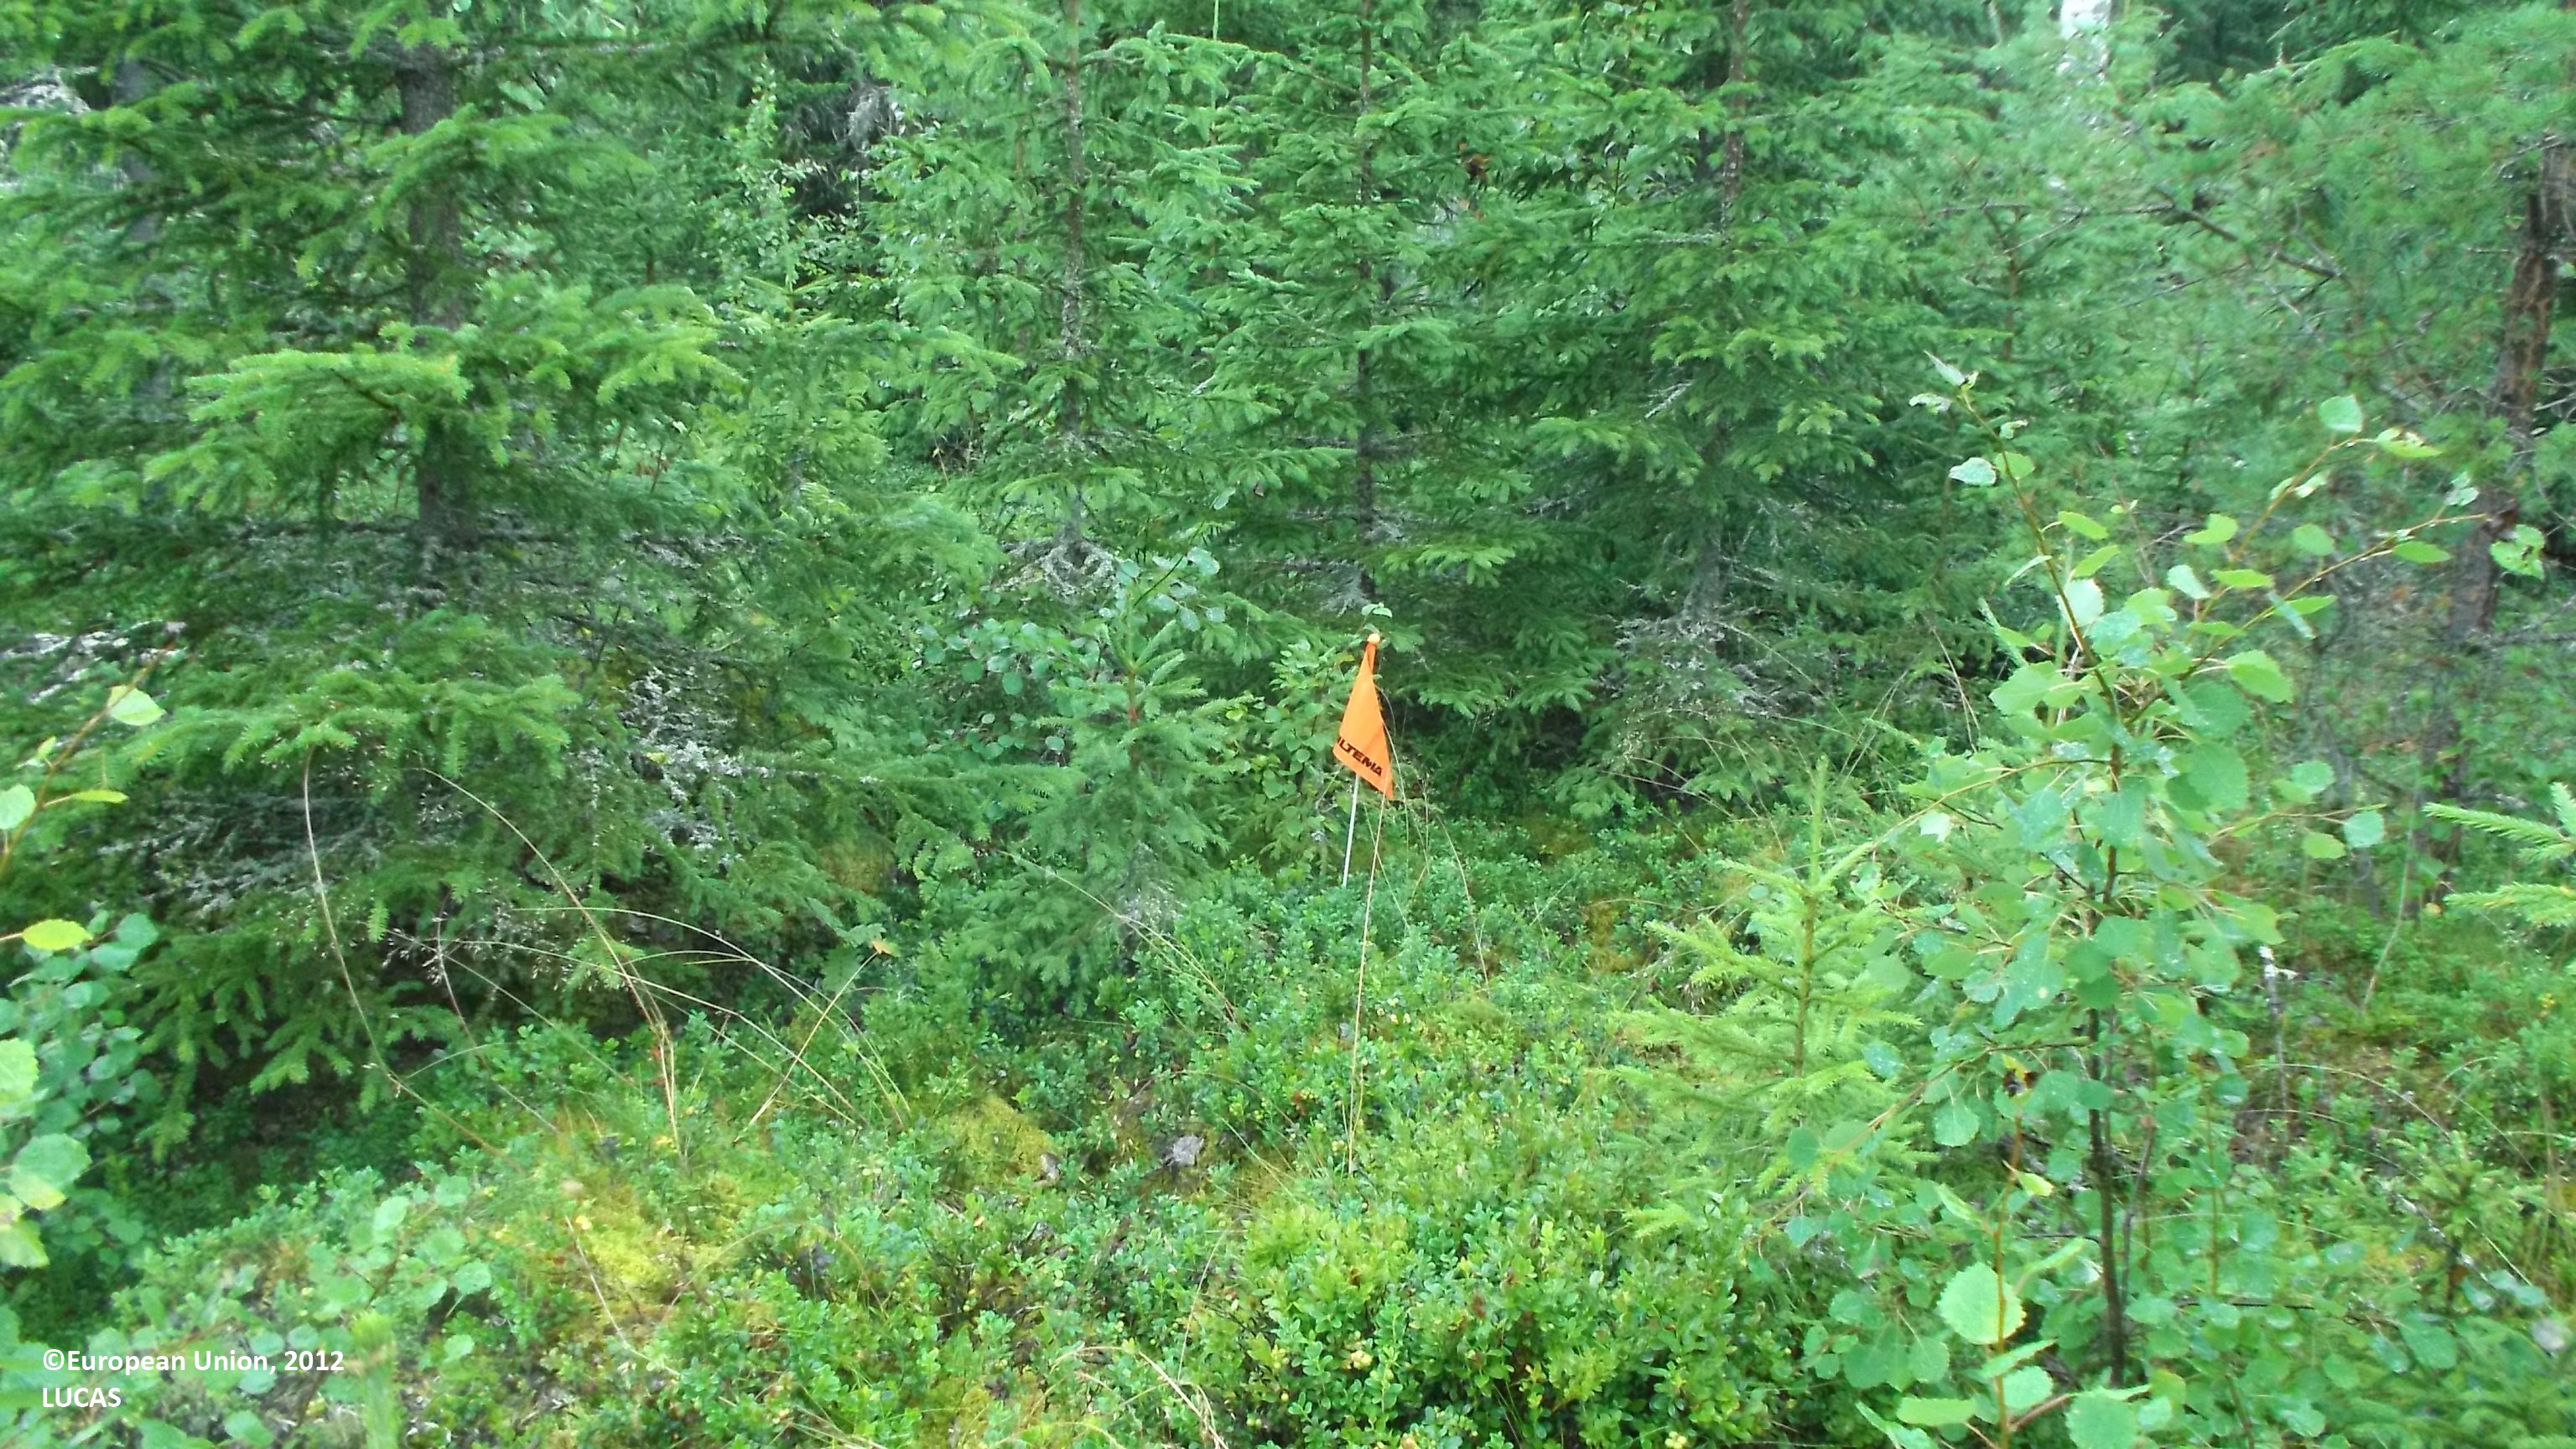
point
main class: Woodland
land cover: Other mixed woodland
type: boreal forest
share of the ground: 50 - 75 %
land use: Forestry
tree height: > 5 m
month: August
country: FI
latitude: 63.7362
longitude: 22.9539
